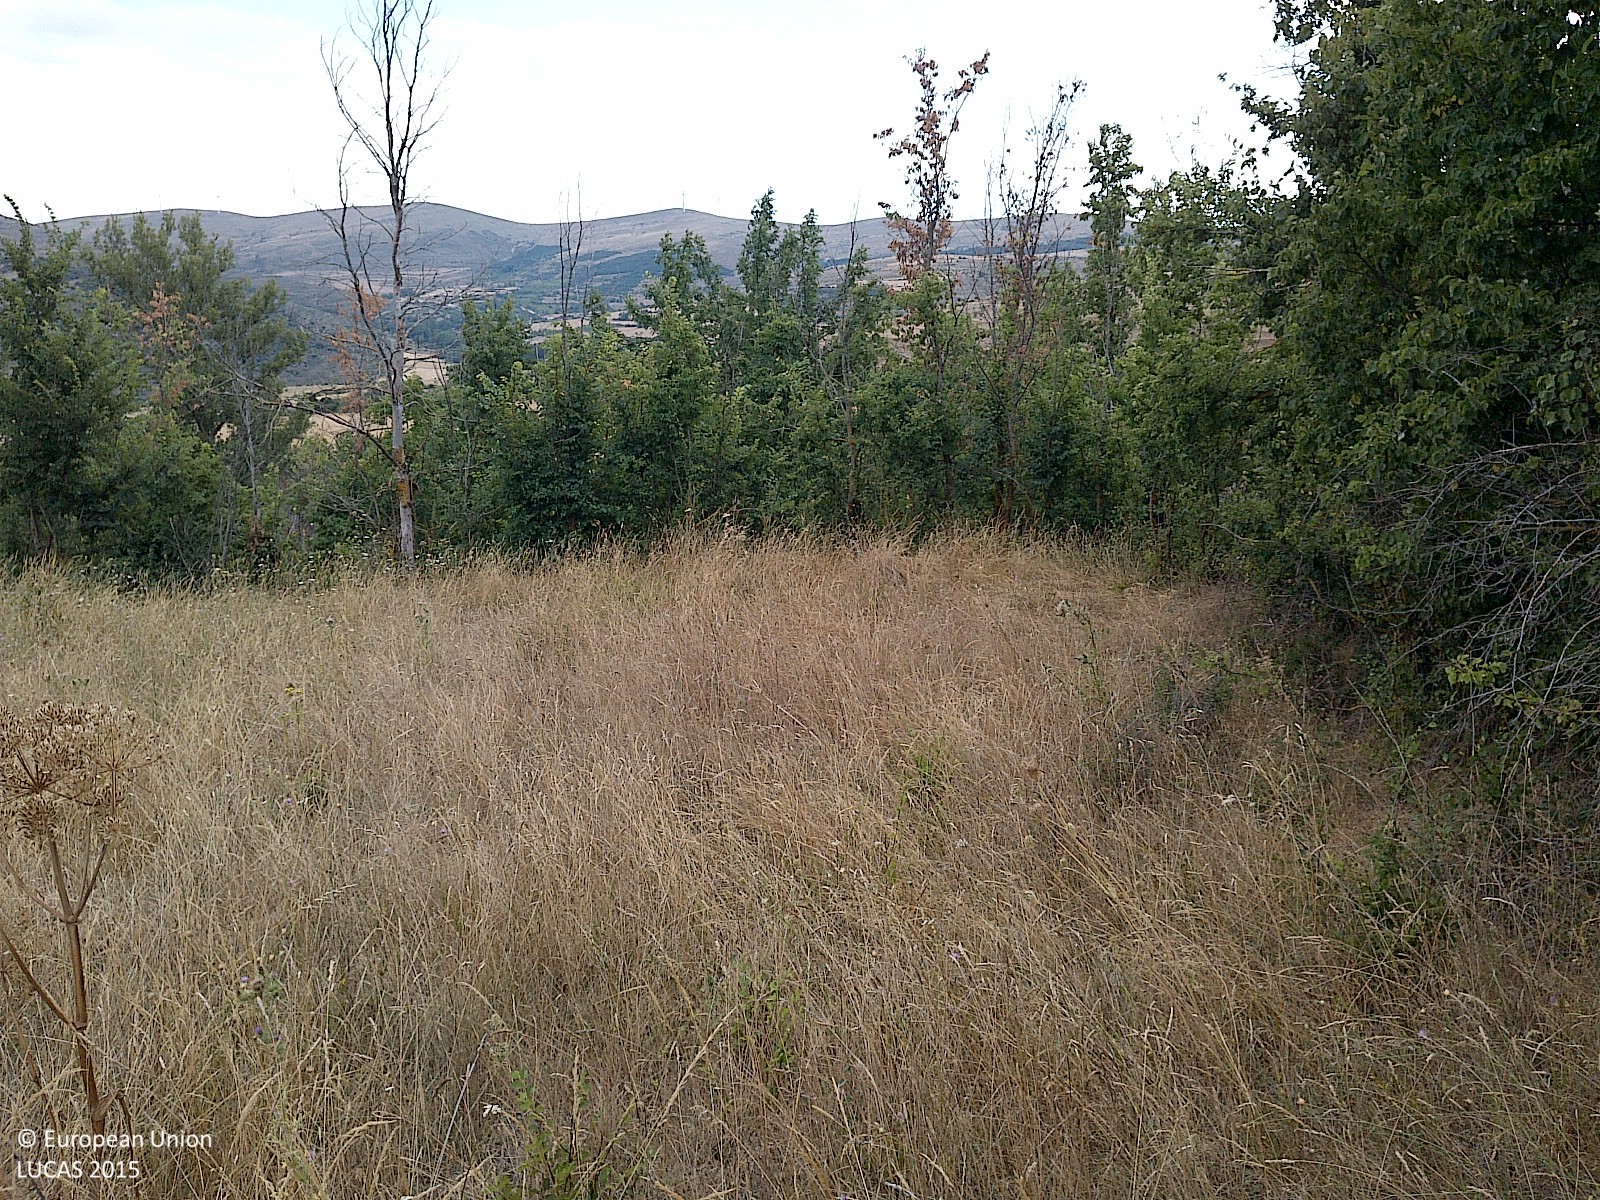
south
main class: Grassland
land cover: Grassland with sparse tree/shrub cover
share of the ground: > 75 %
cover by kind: herbaceous plants 90 %, broadleaved forest trees 5 %, shrubs 5 %
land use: Agriculture (excluding fallow land and kitchen gardens)
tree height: < 5 m
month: July
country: ES
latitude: 41.9966
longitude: -2.2672
